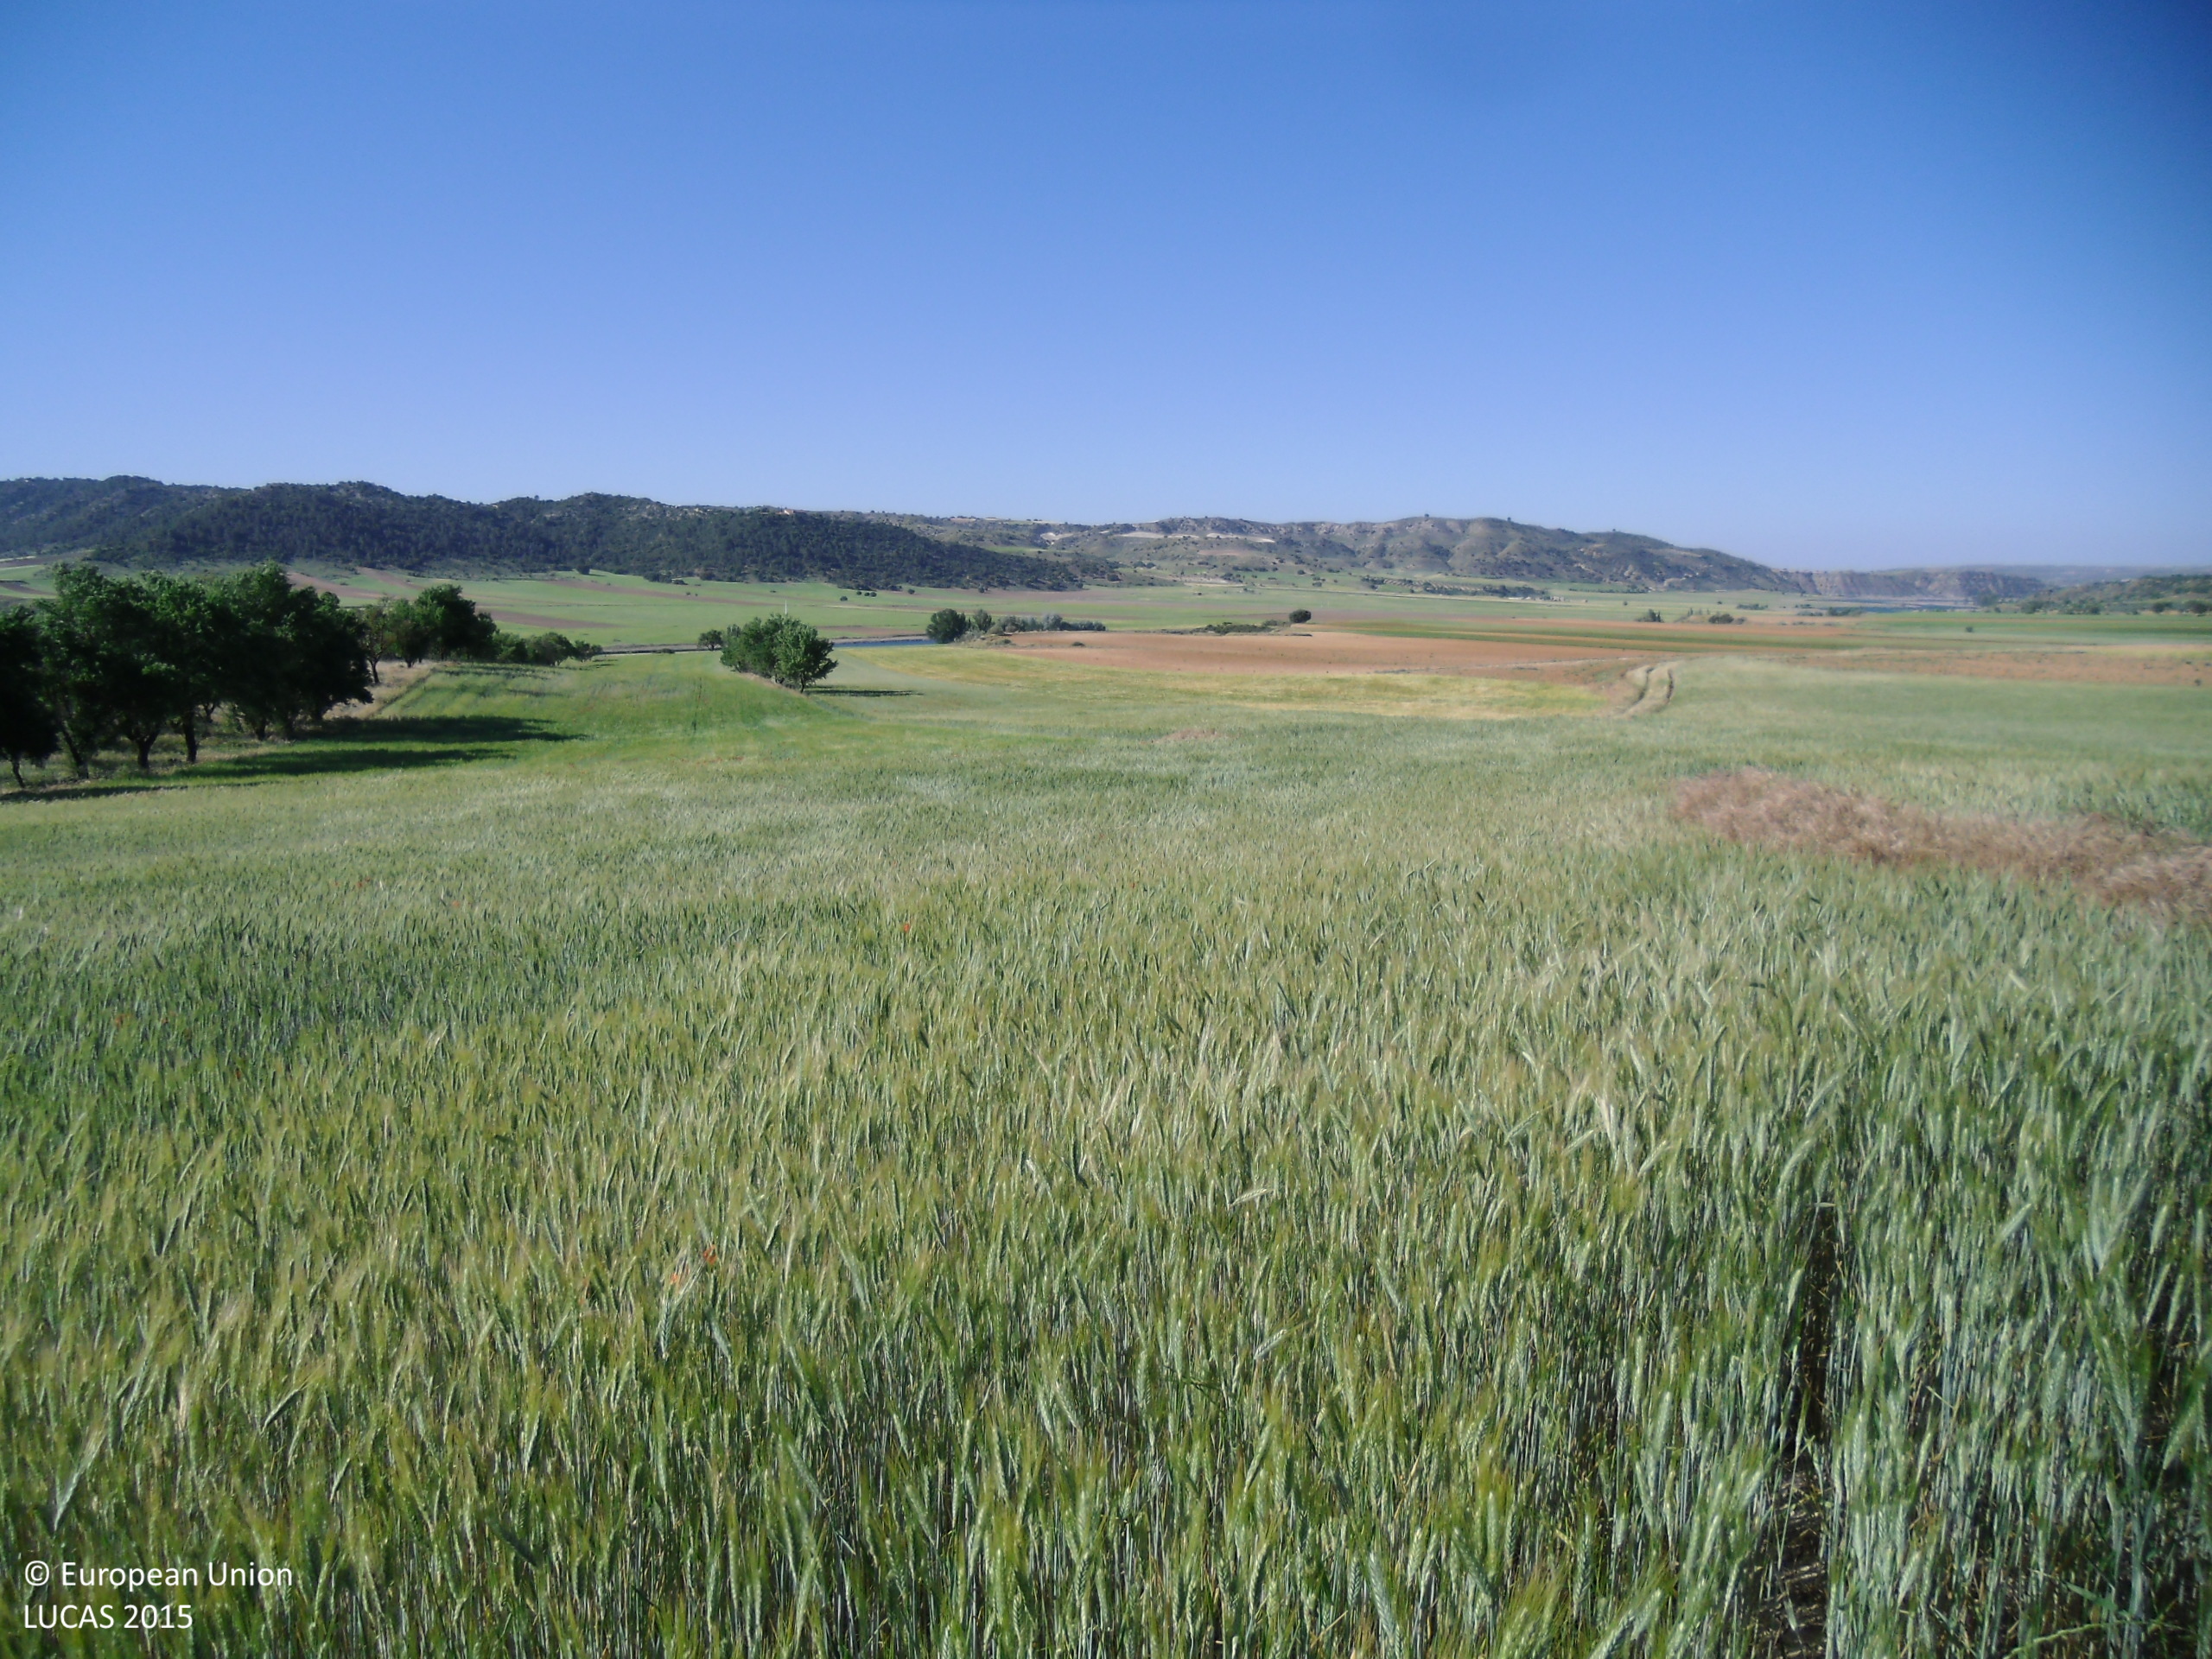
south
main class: Shrubland
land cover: Shrubland without tree cover
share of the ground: 25 - 50 %
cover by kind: herbaceous plants 70 %, shrubs 30 %
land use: Semi-natural and natural areas not in use
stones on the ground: < 10 %
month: May
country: ES
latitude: 40.3069
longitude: -2.9103
